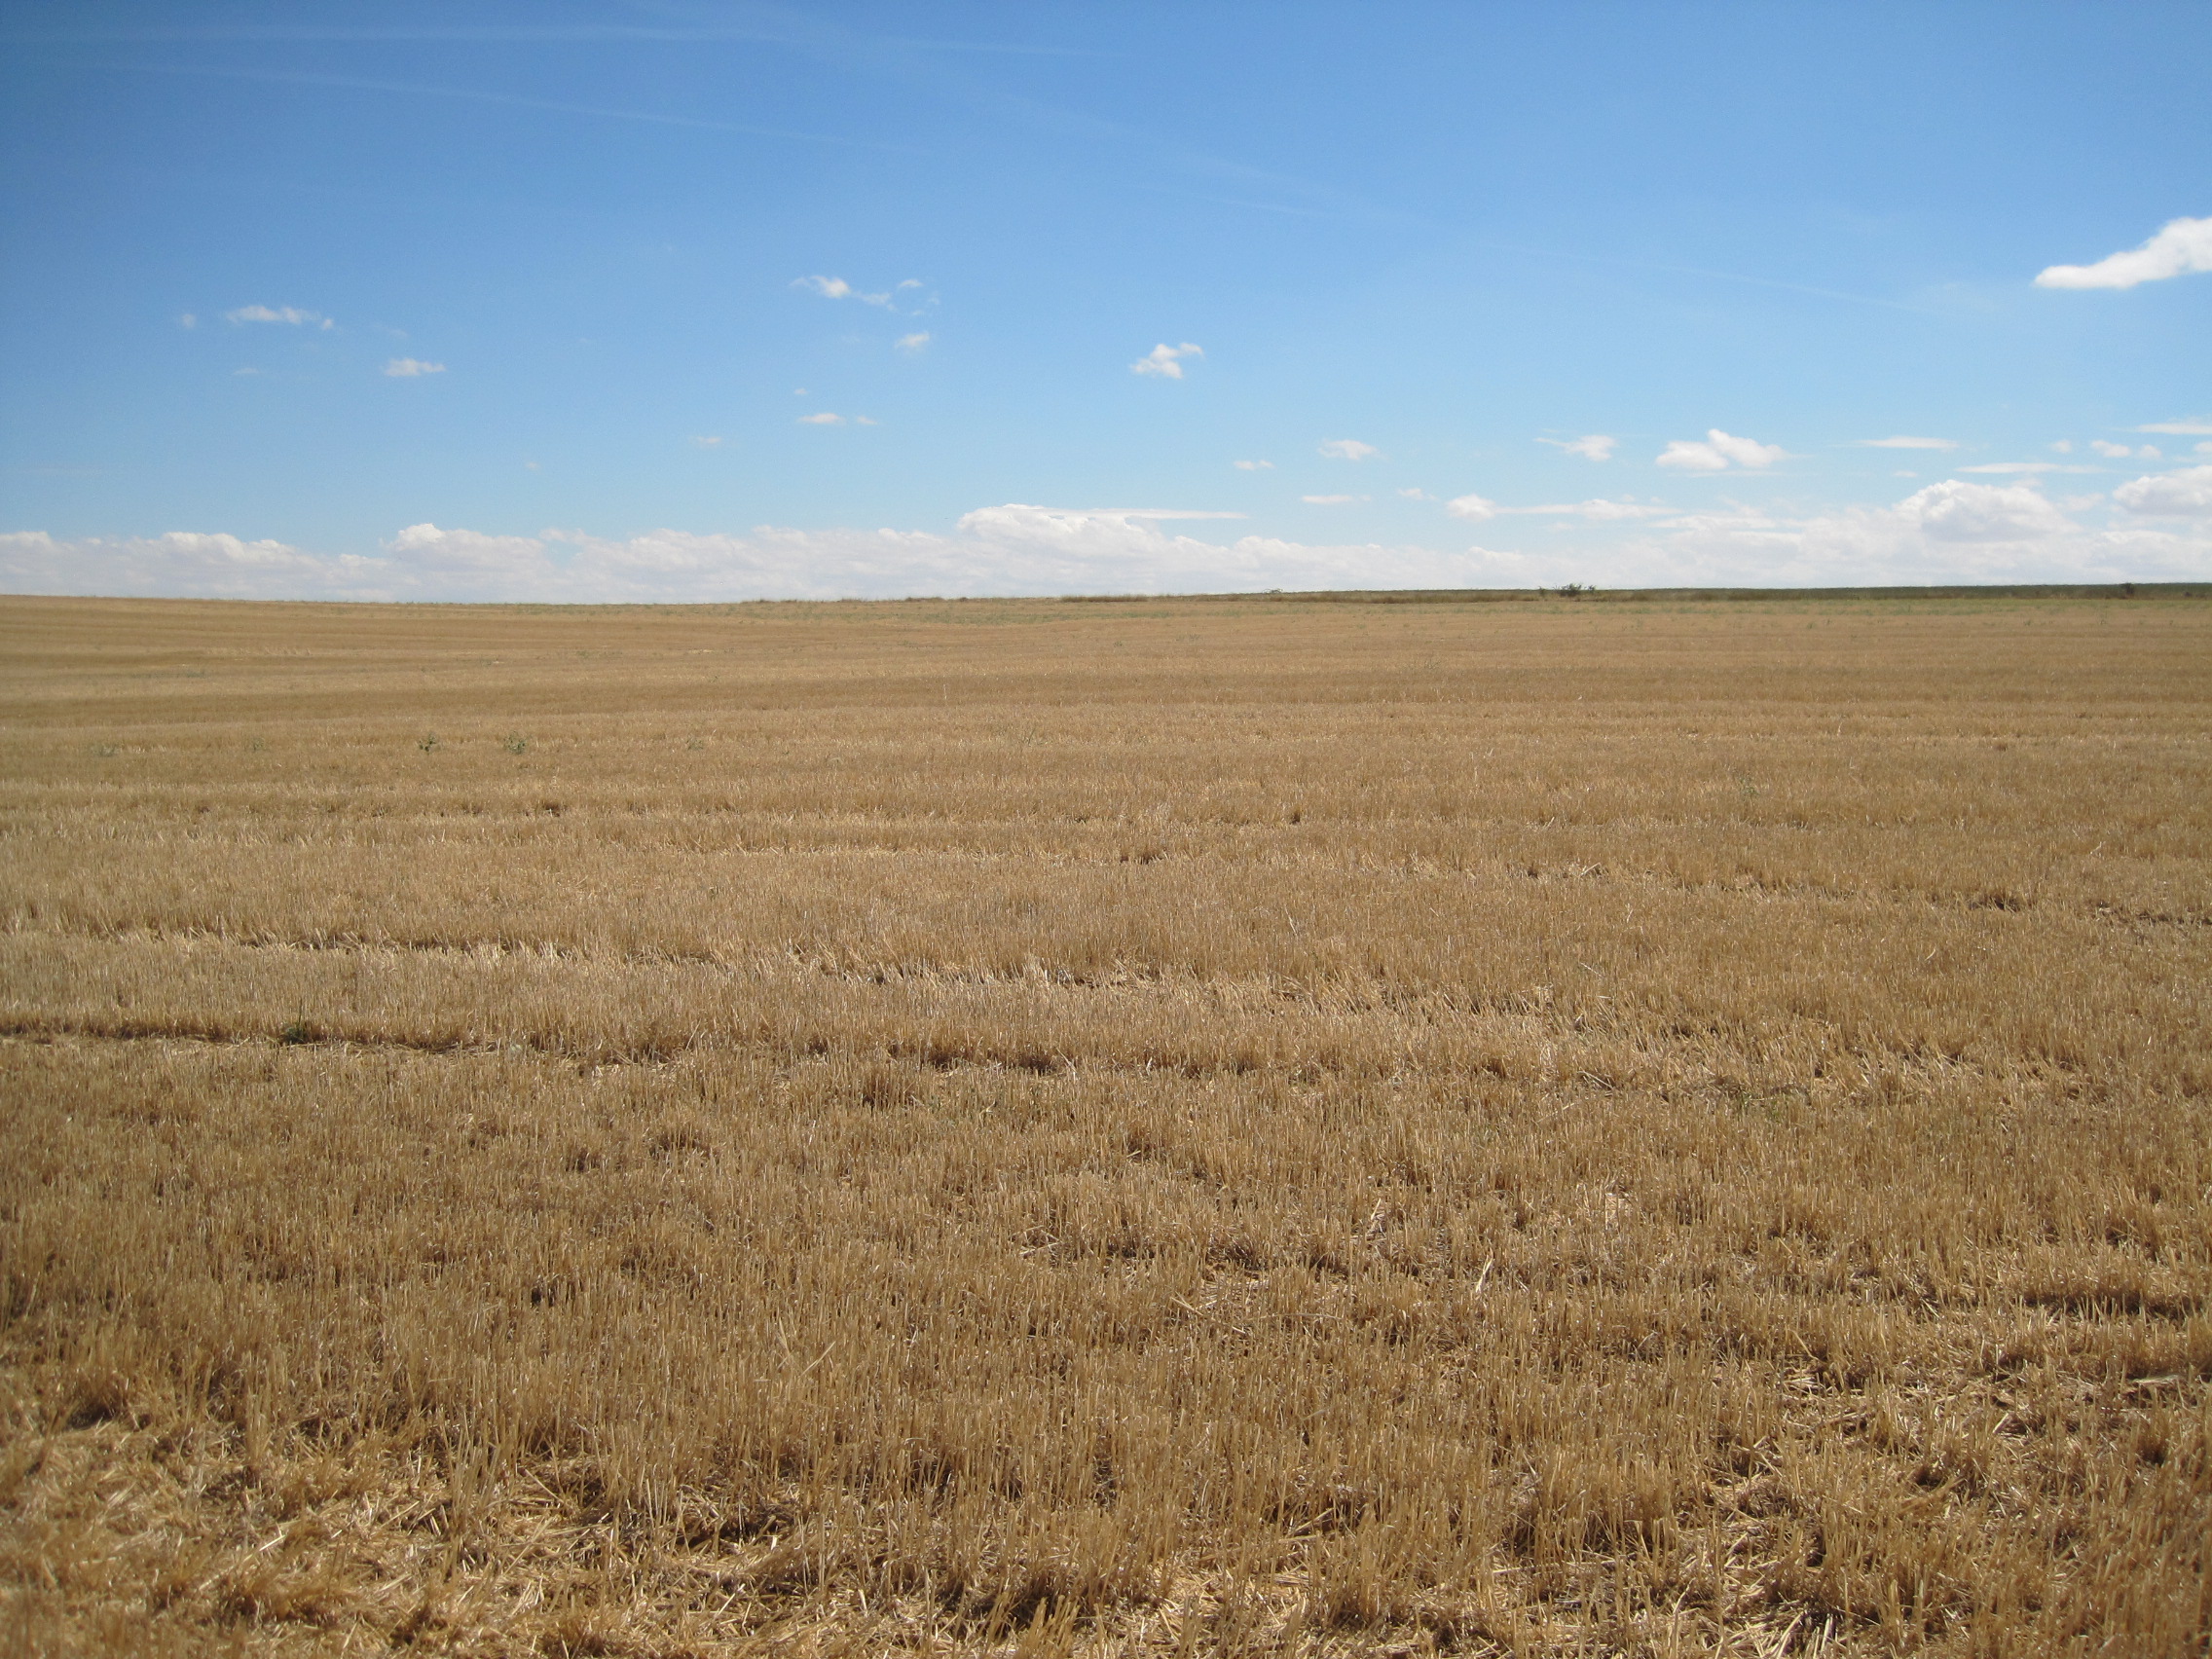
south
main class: Cropland
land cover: Barley
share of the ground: < 10 %
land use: Agriculture (excluding fallow land and kitchen gardens)
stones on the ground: < 10 %
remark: Harvested field
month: July
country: ES
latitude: 41.9932
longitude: -5.2079
